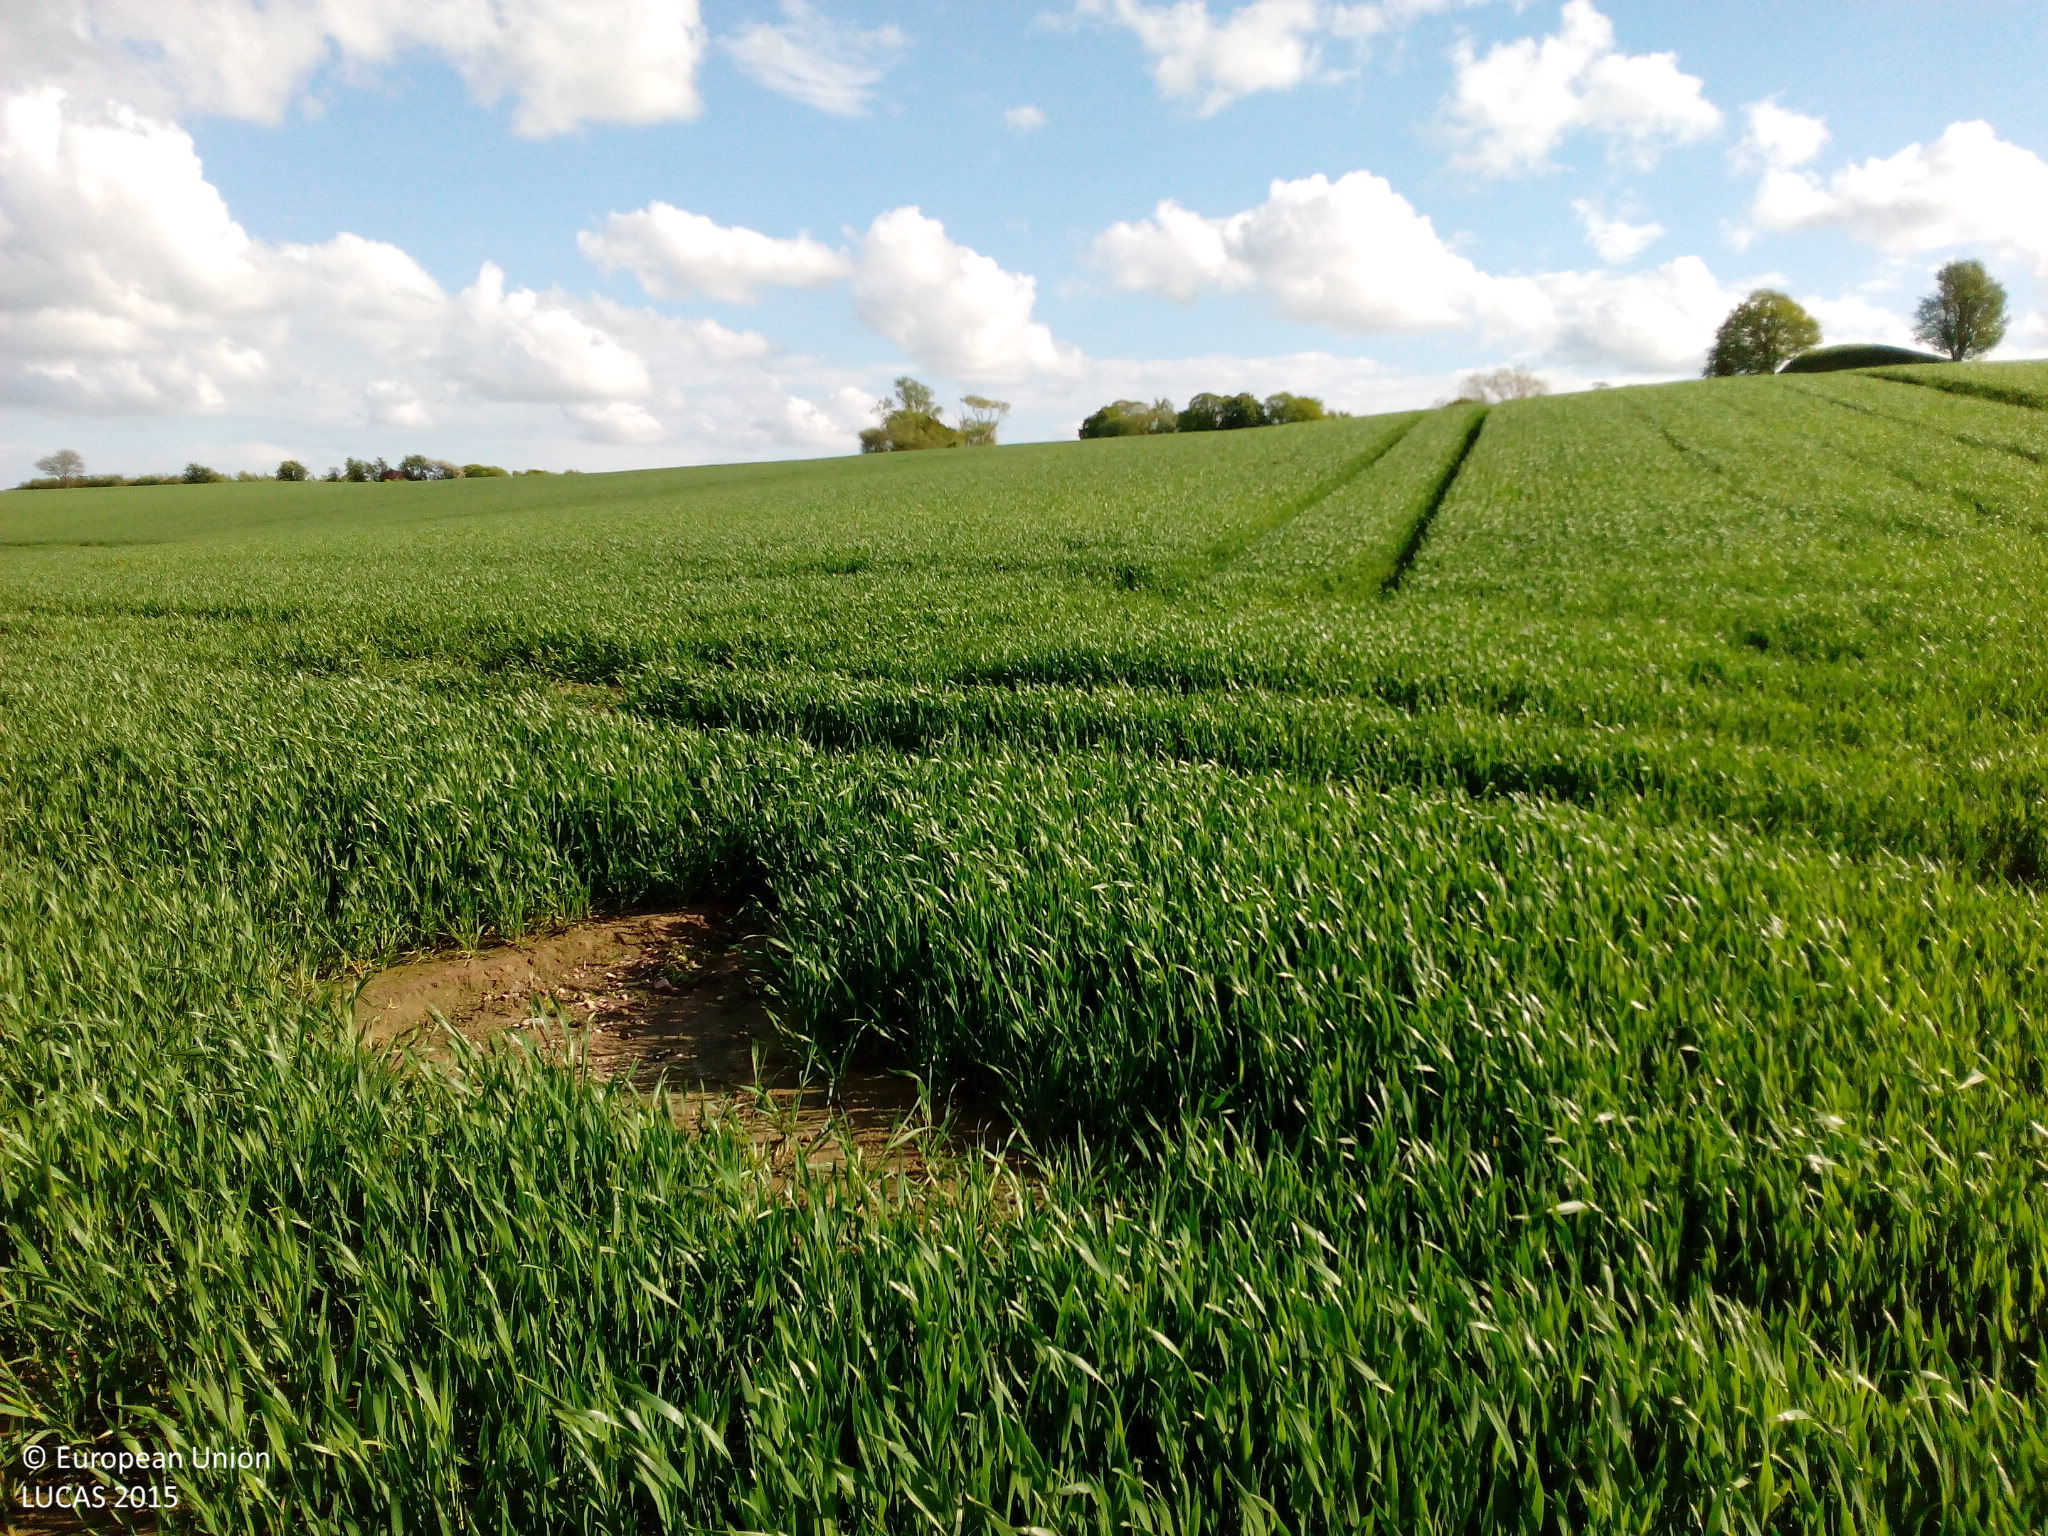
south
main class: Cropland
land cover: Common wheat
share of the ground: > 75 %
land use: Agriculture (excluding fallow land and kitchen gardens)
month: May
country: DK
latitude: 55.5781
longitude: 12.0445
